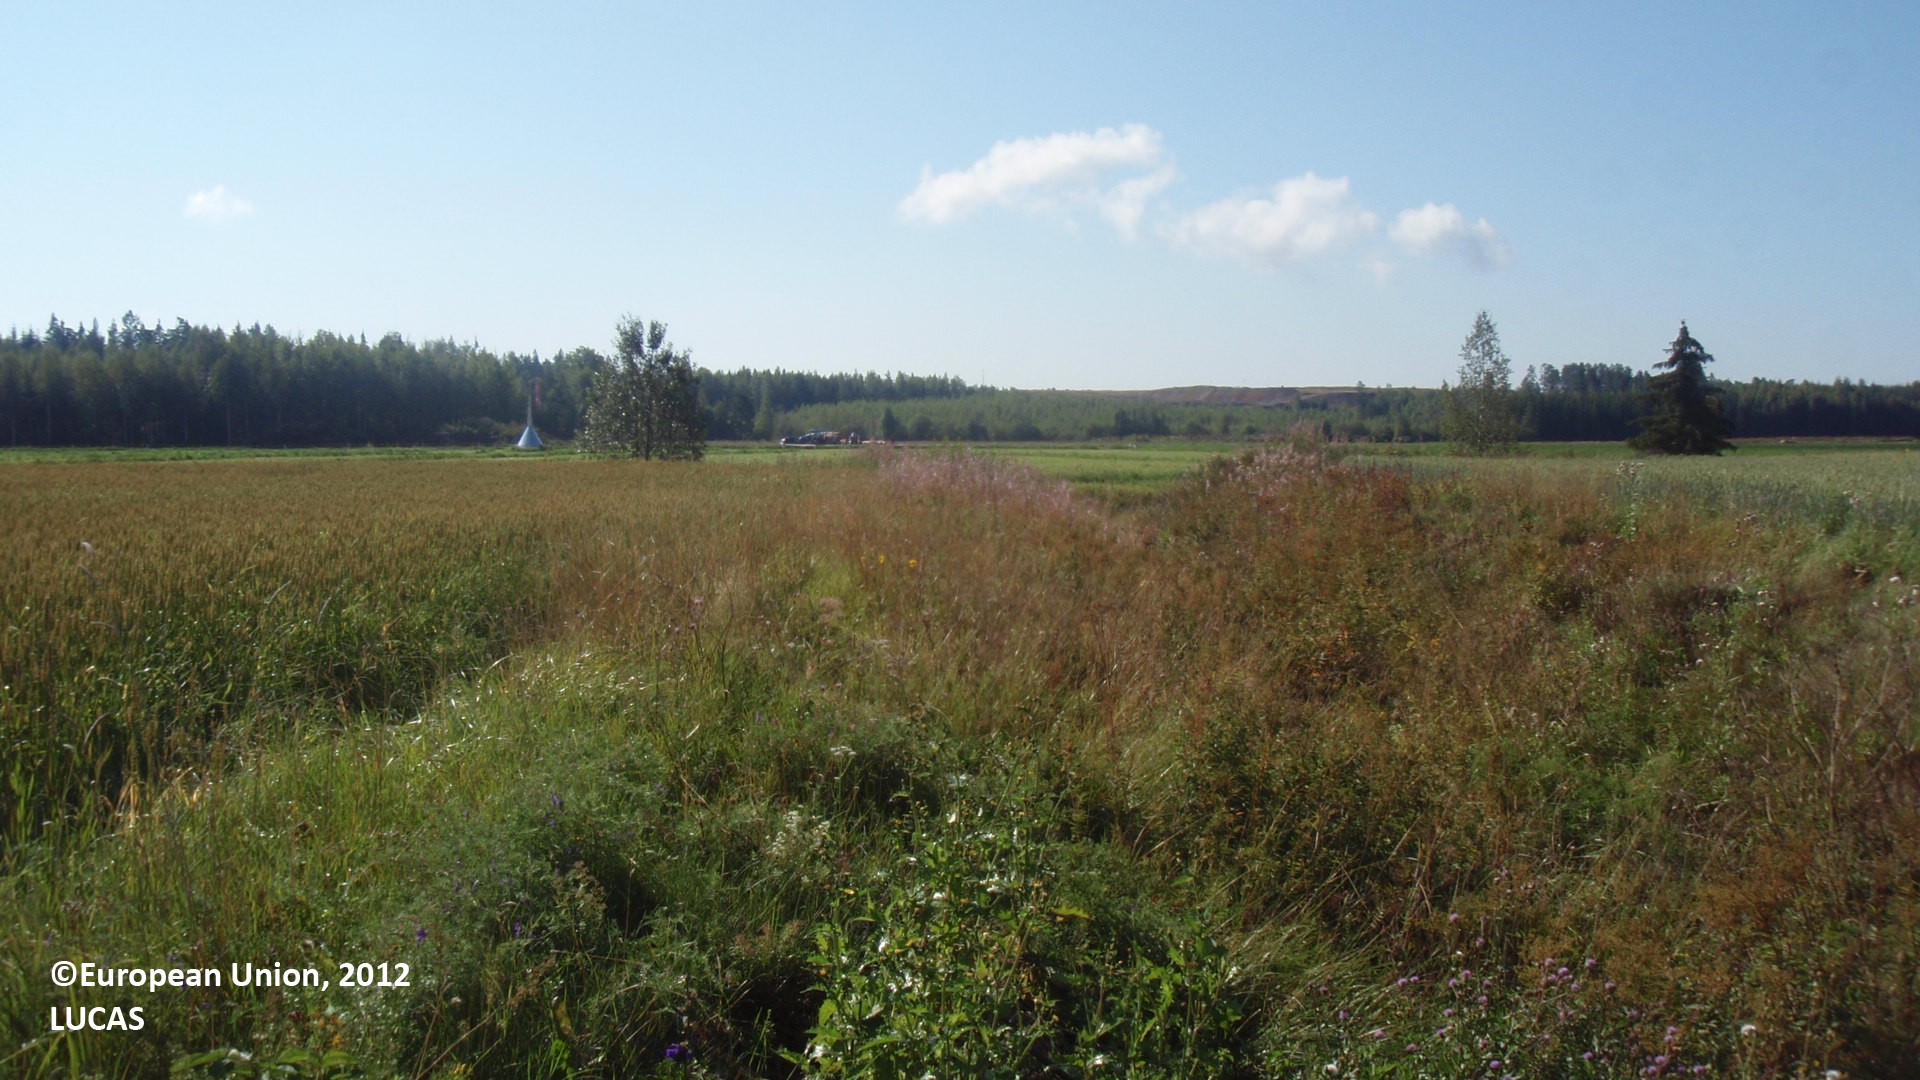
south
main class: Shrubland
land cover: Shrubland with sparse tree cover
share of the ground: > 75 %
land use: Agriculture (excluding fallow land and kitchen gardens)
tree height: < 5 m
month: August
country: FI
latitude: 60.7587
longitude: 26.7324
